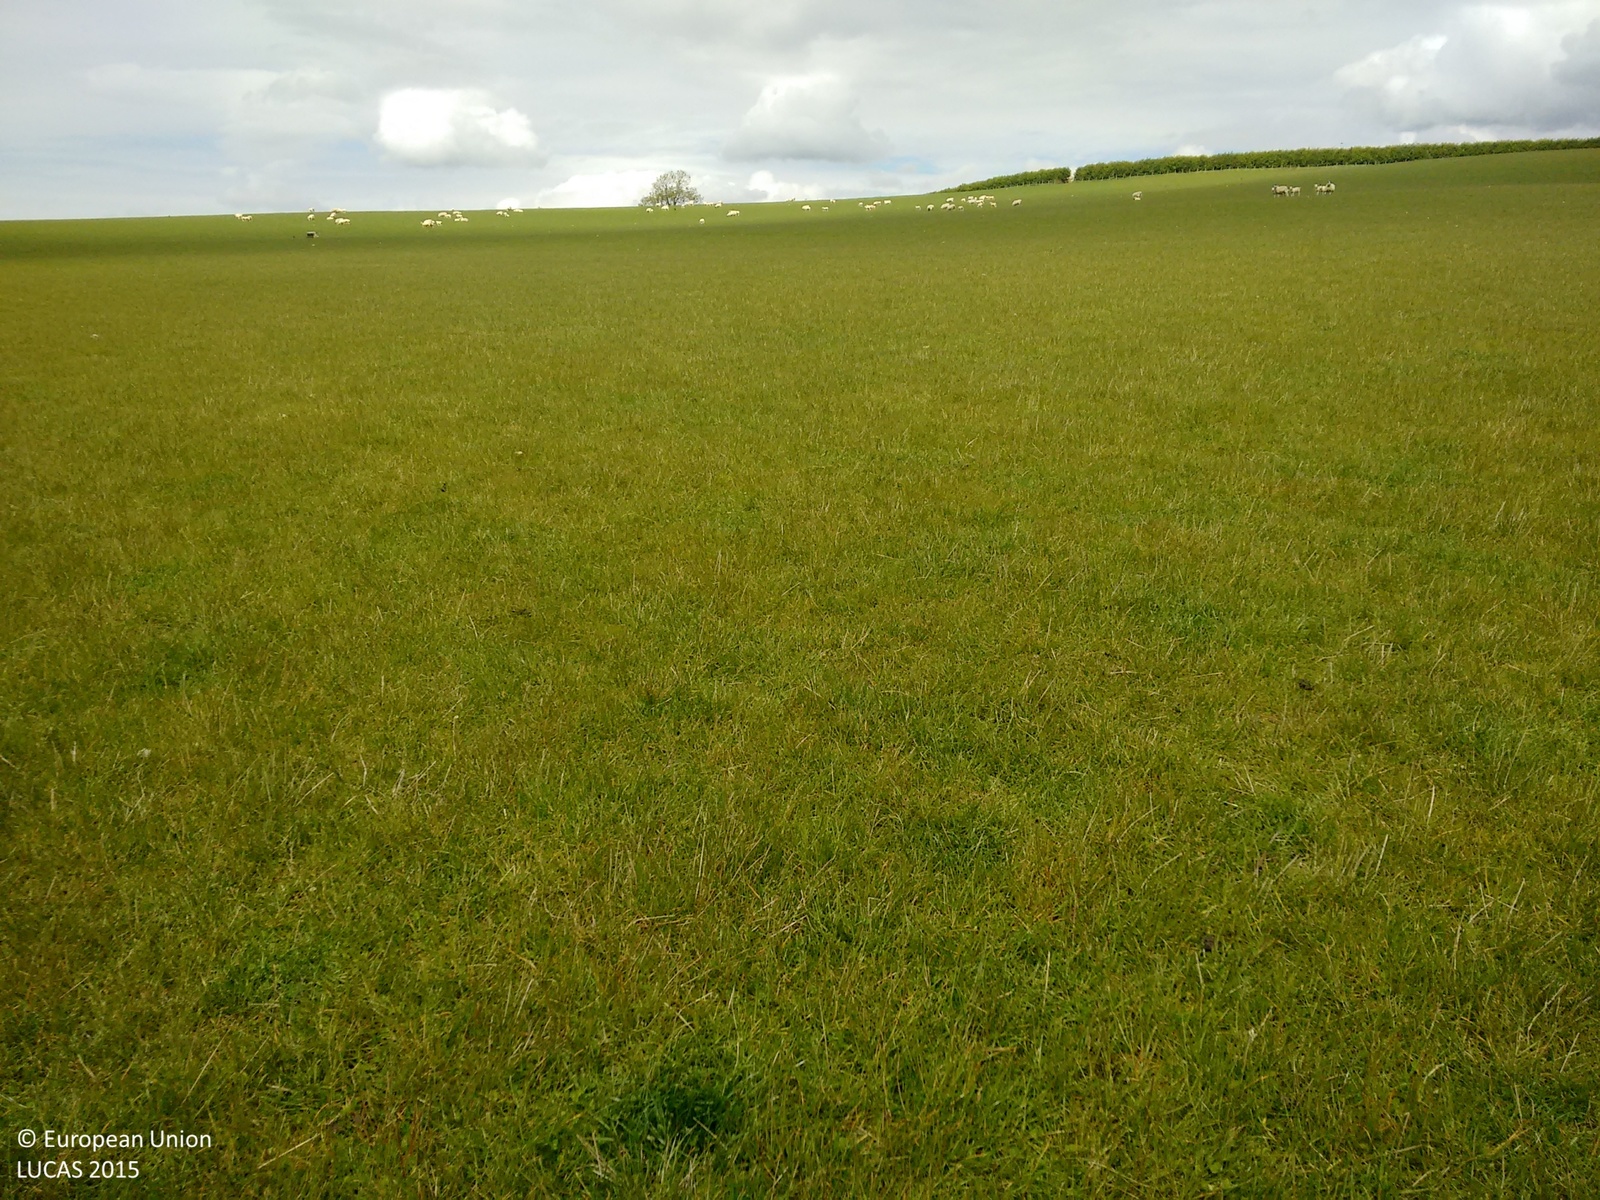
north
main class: Grassland
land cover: Grassland without tree/shrub cover
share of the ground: > 75 %
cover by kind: herbaceous plants 100 %
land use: Agriculture (excluding fallow land and kitchen gardens)
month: June
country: GB
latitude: 55.6316
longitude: -2.4652
